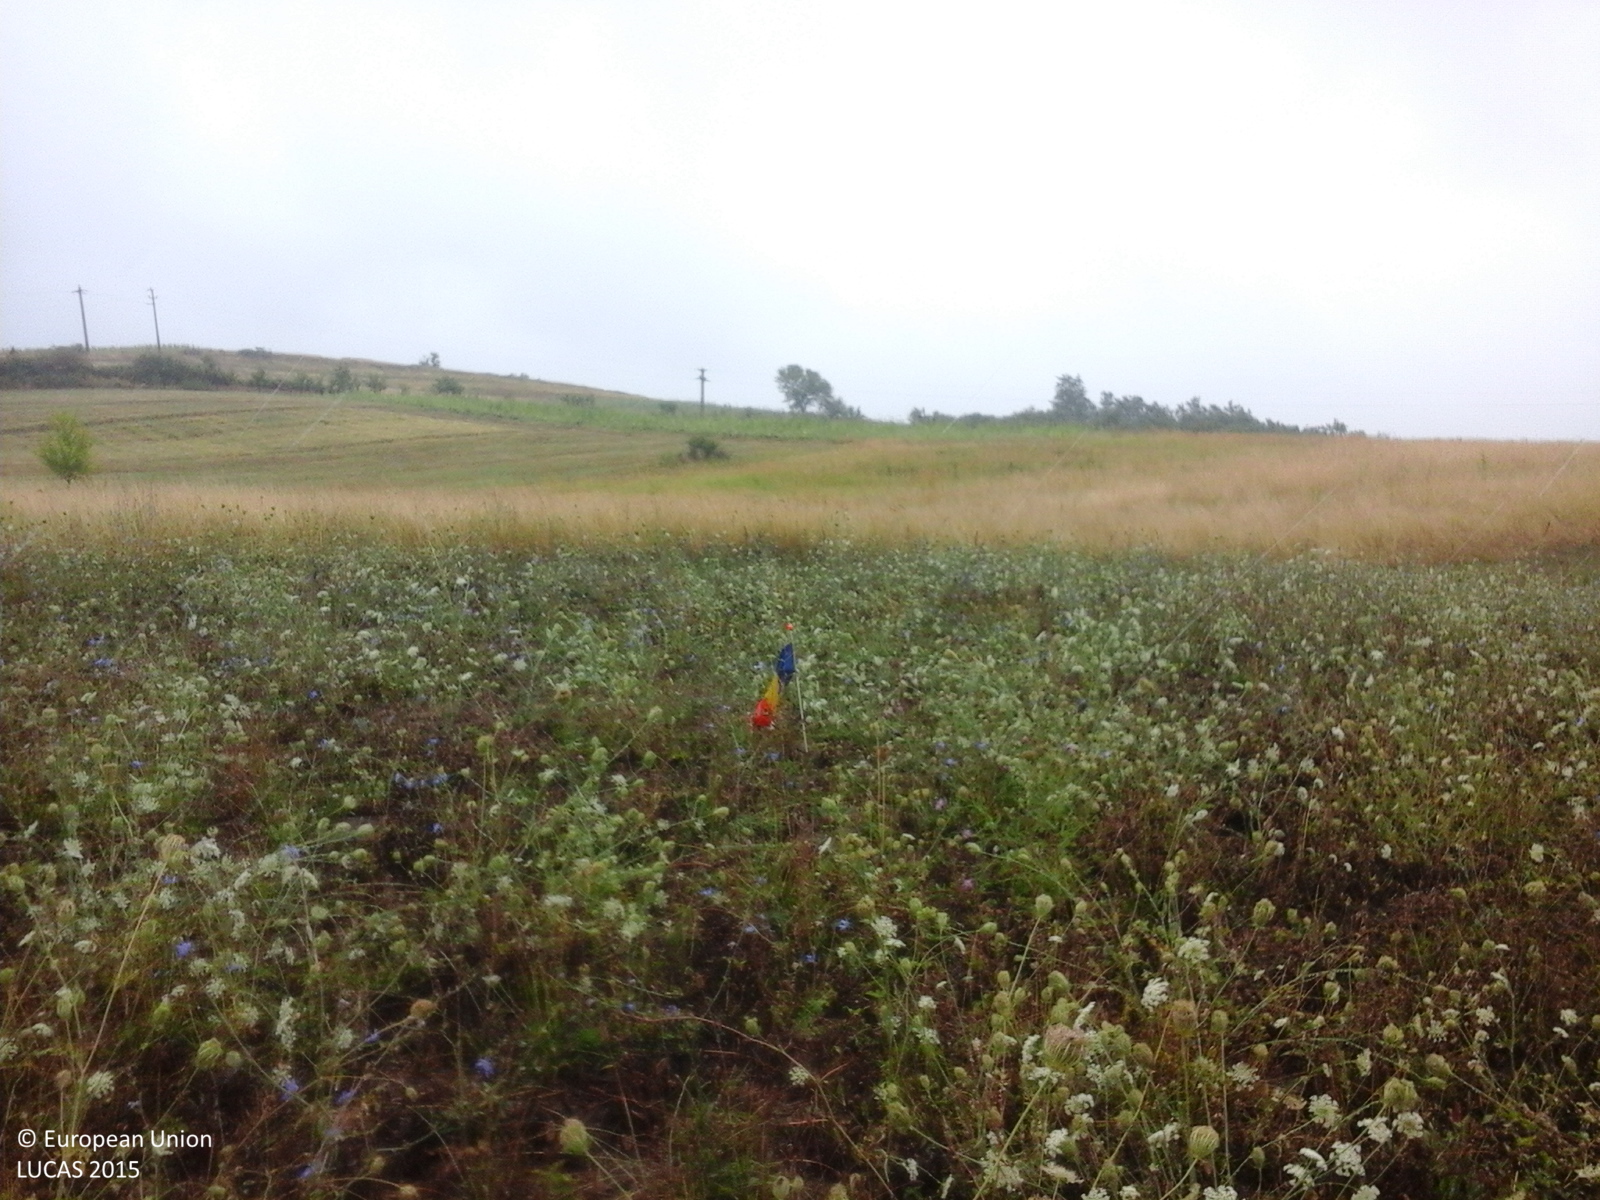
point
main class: Grassland
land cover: Spontaneously vegetated surfaces
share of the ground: > 75 %
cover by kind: herbaceous plants 100 %
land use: Fallow land
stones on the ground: 25 - 50 %
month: August
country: RO
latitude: 44.8814
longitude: 22.0749
